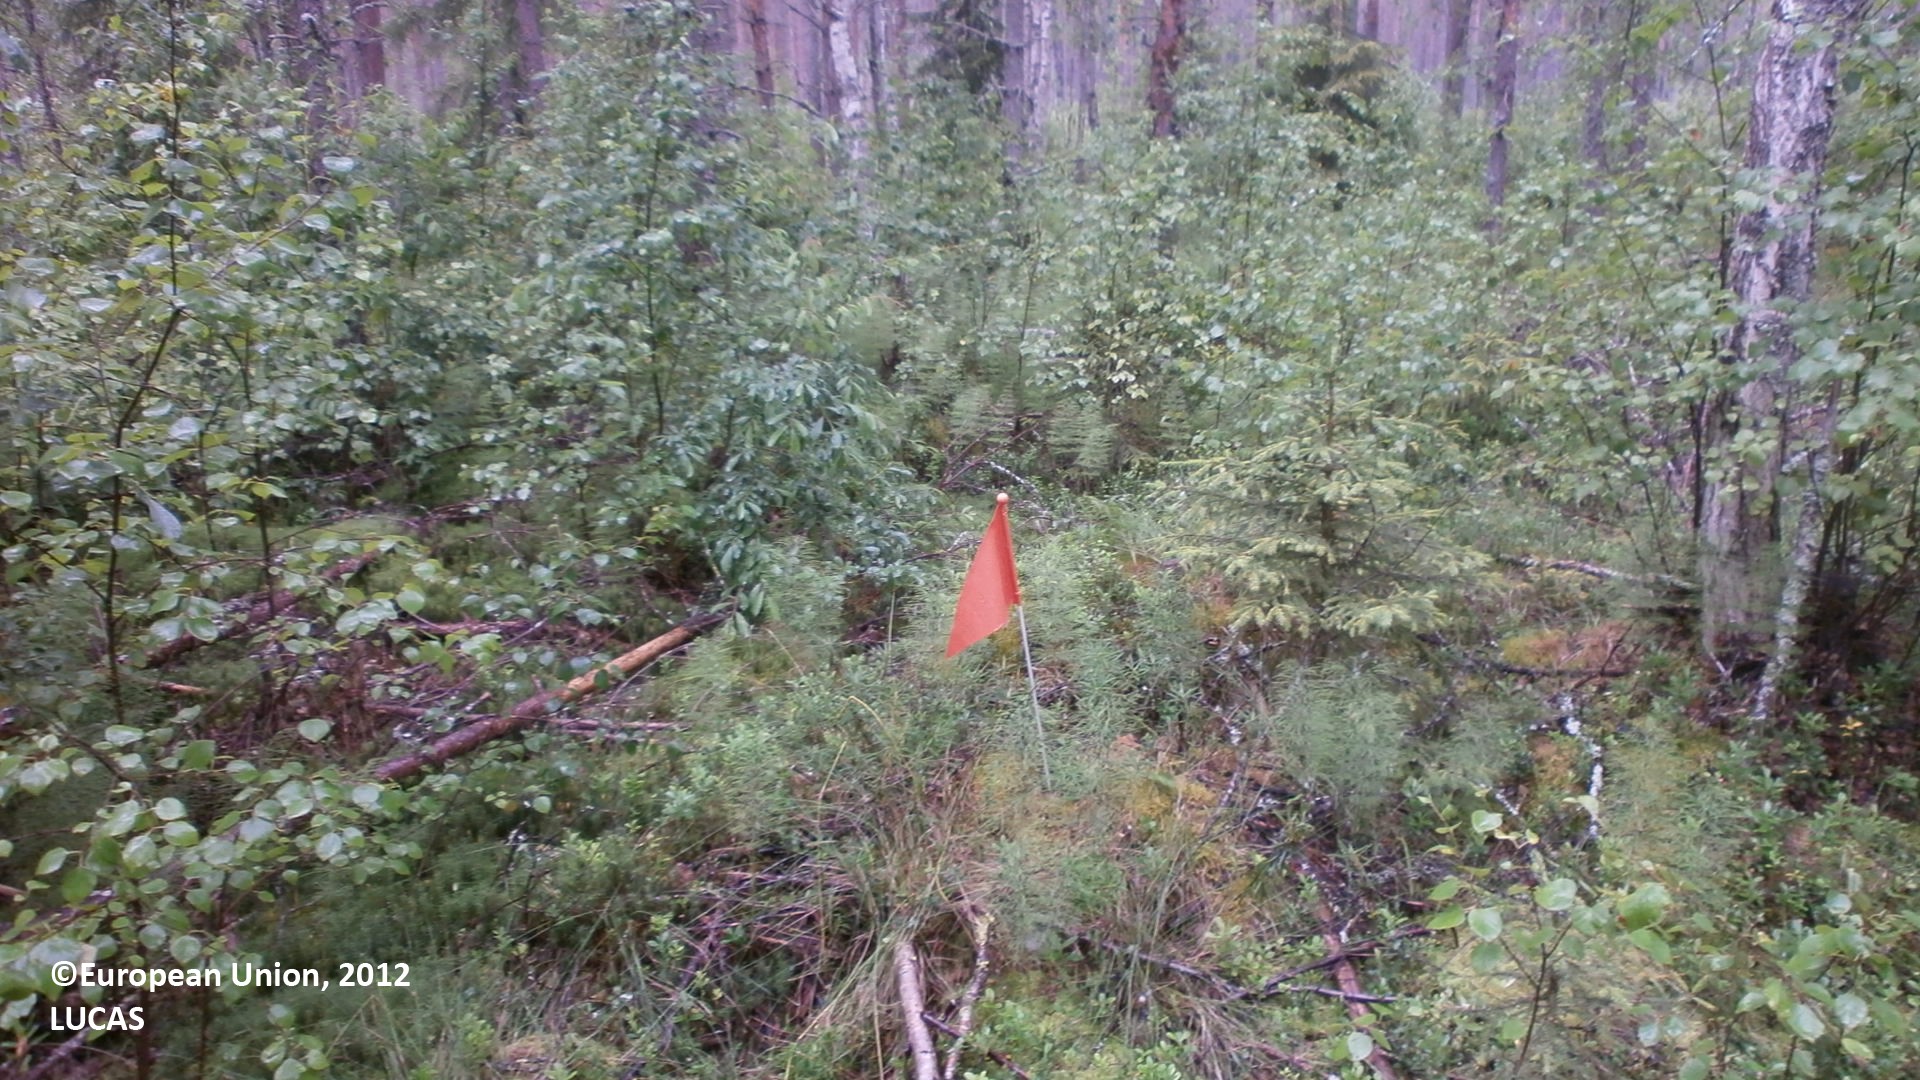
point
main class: Woodland
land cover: Pine dominated coniferous woodland
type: boreal forest
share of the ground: 50 - 75 %
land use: Forestry
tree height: > 5 m
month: July
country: FI
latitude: 64.0663
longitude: 23.8132
